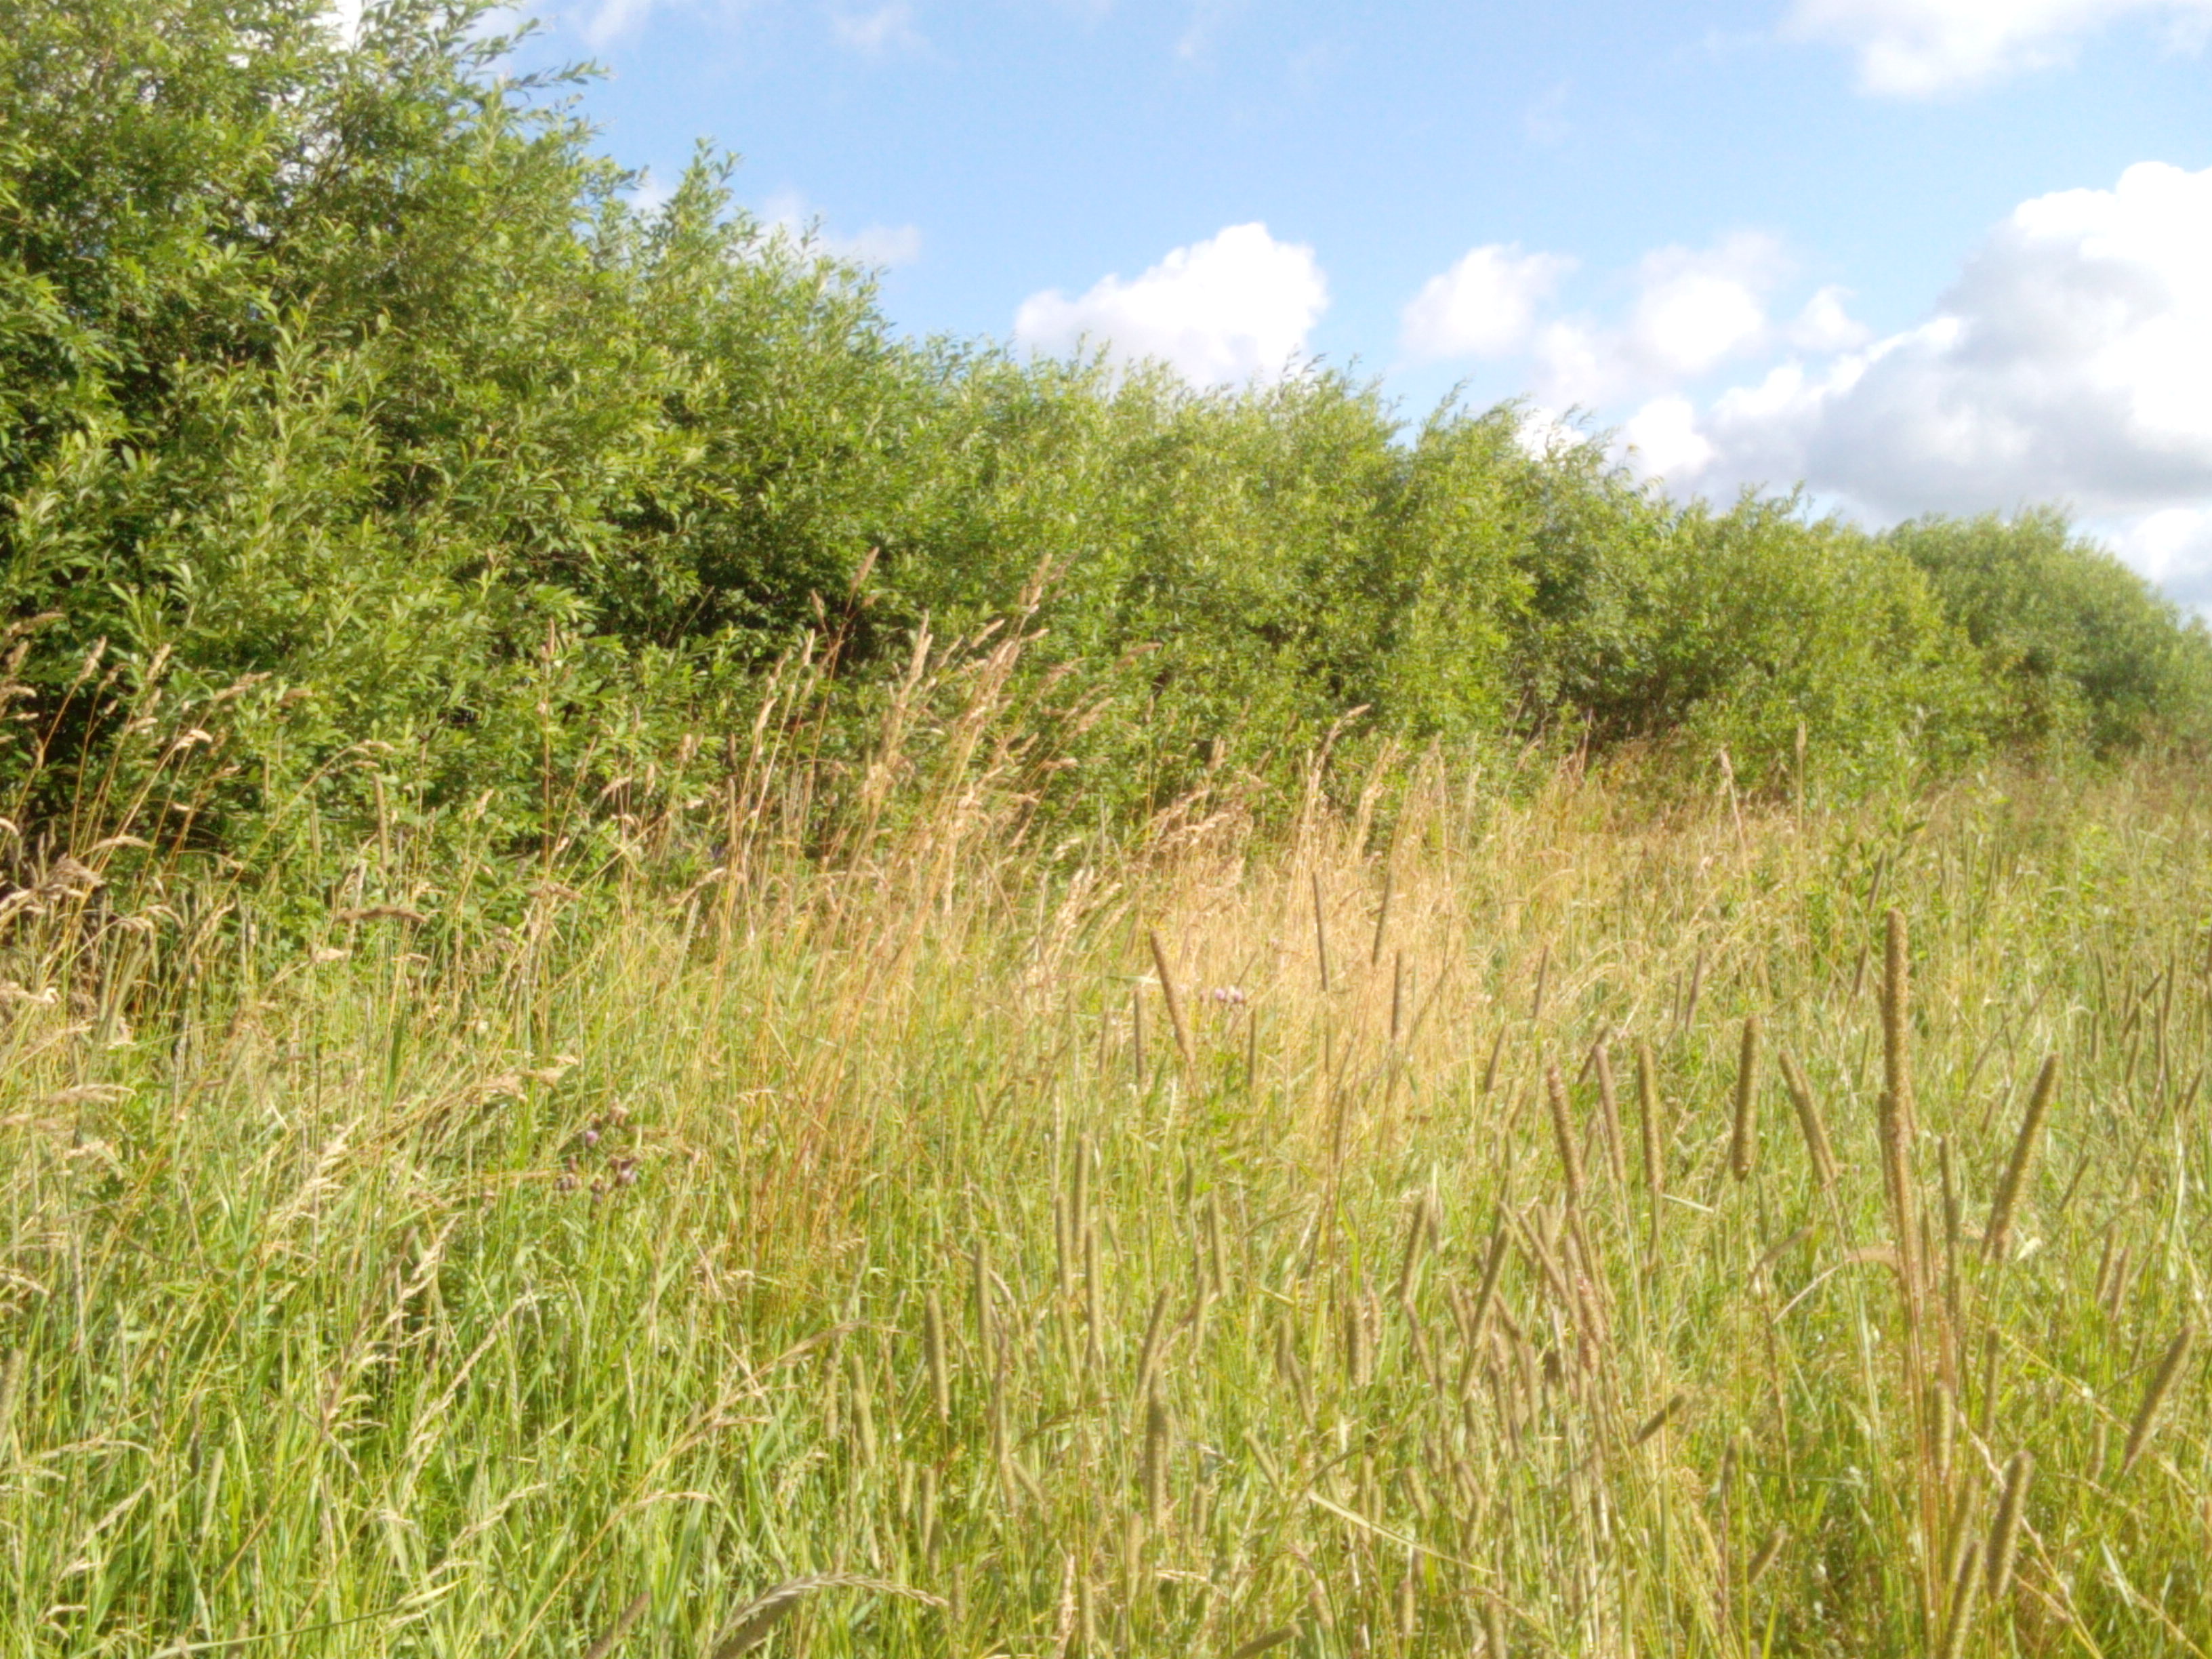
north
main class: Grassland
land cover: Grassland without tree/shrub cover
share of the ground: > 75 %
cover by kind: herbaceous plants 95 %, shrubs 5 %
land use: Agriculture (excluding fallow land and kitchen gardens)
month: July
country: LV
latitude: 56.6848
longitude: 21.3196
